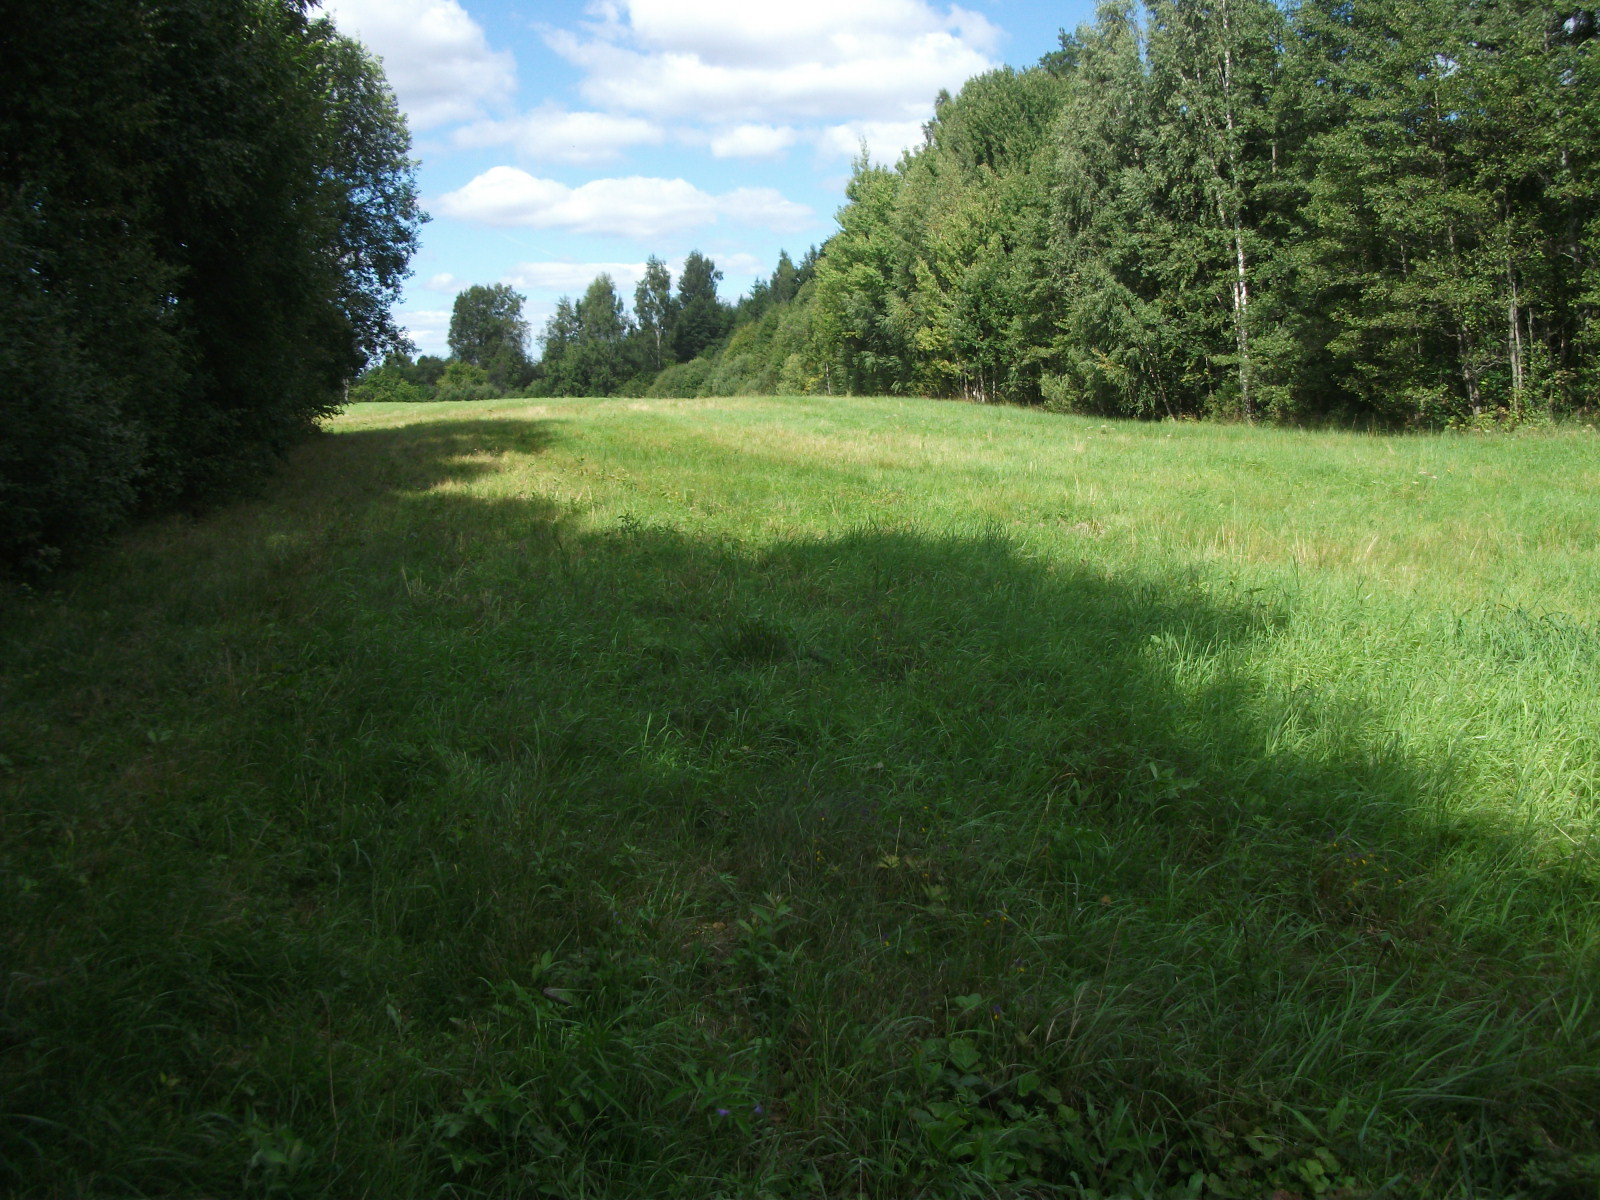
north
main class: Grassland
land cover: Grassland without tree/shrub cover
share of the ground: > 75 %
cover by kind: herbaceous plants 100 %
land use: Agriculture (excluding fallow land and kitchen gardens)
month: August
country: LV
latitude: 56.5663
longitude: 26.4692
